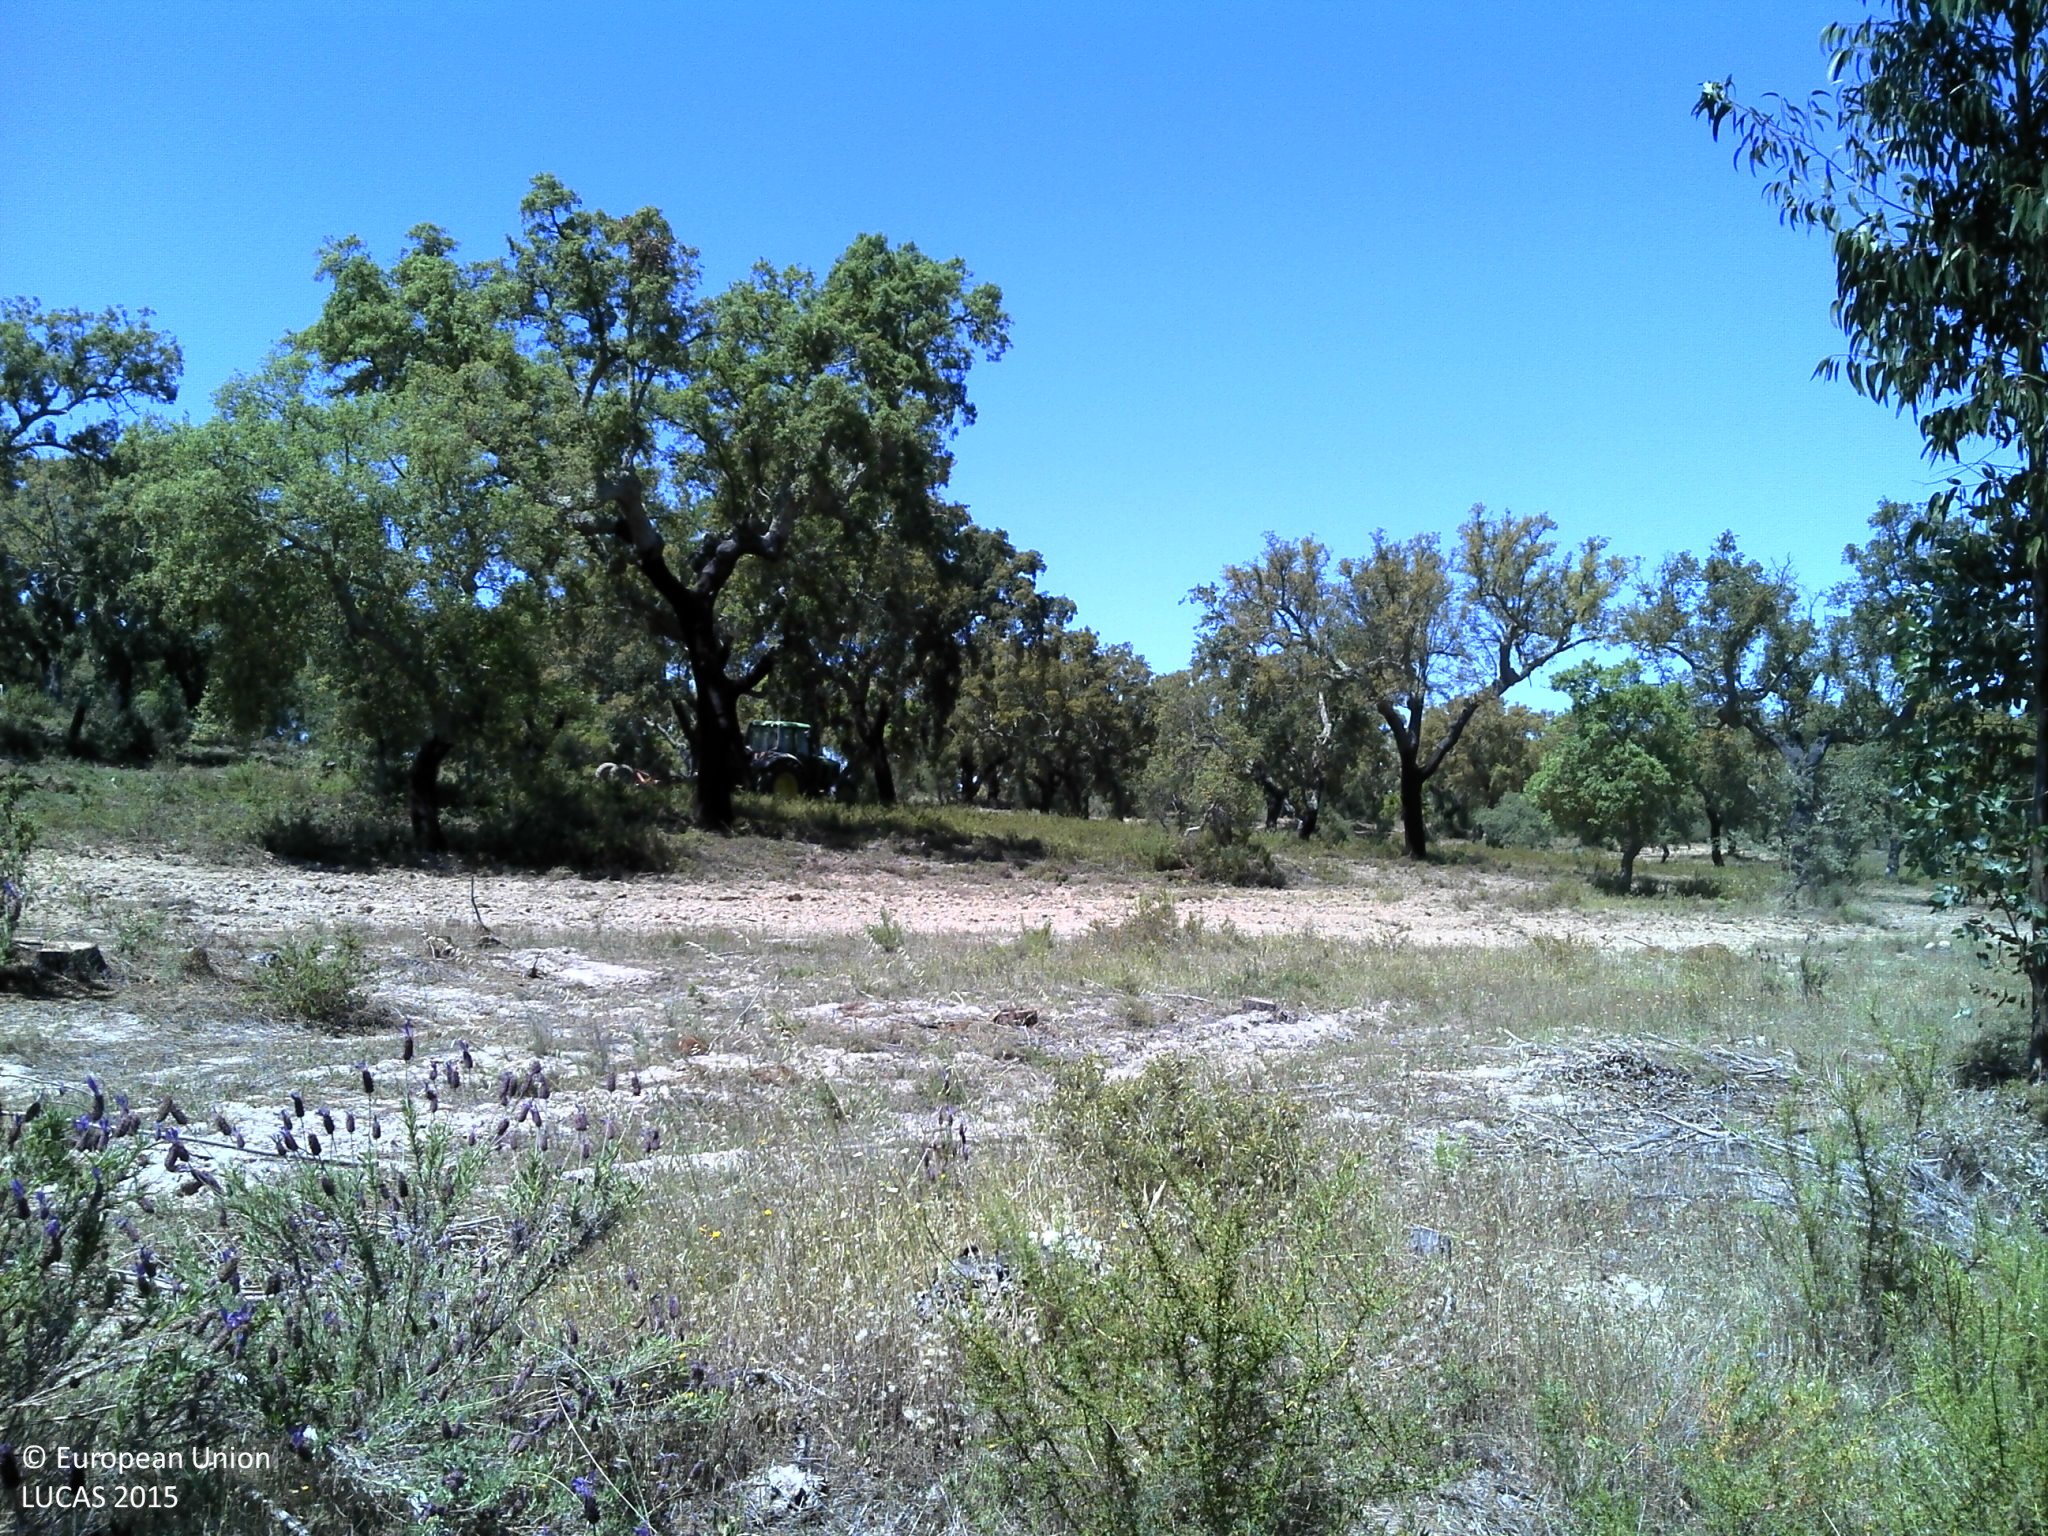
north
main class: Woodland
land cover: Broadleaved woodland
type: exotic forest
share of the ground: 25 - 50 %
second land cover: Shrubland without tree cover
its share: 50 - 75 %
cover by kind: broadleaved forest trees 50 %, shrubs 50 %
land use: Forestry
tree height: > 5 m
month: May
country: PT
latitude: 39.2074
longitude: -7.9444
